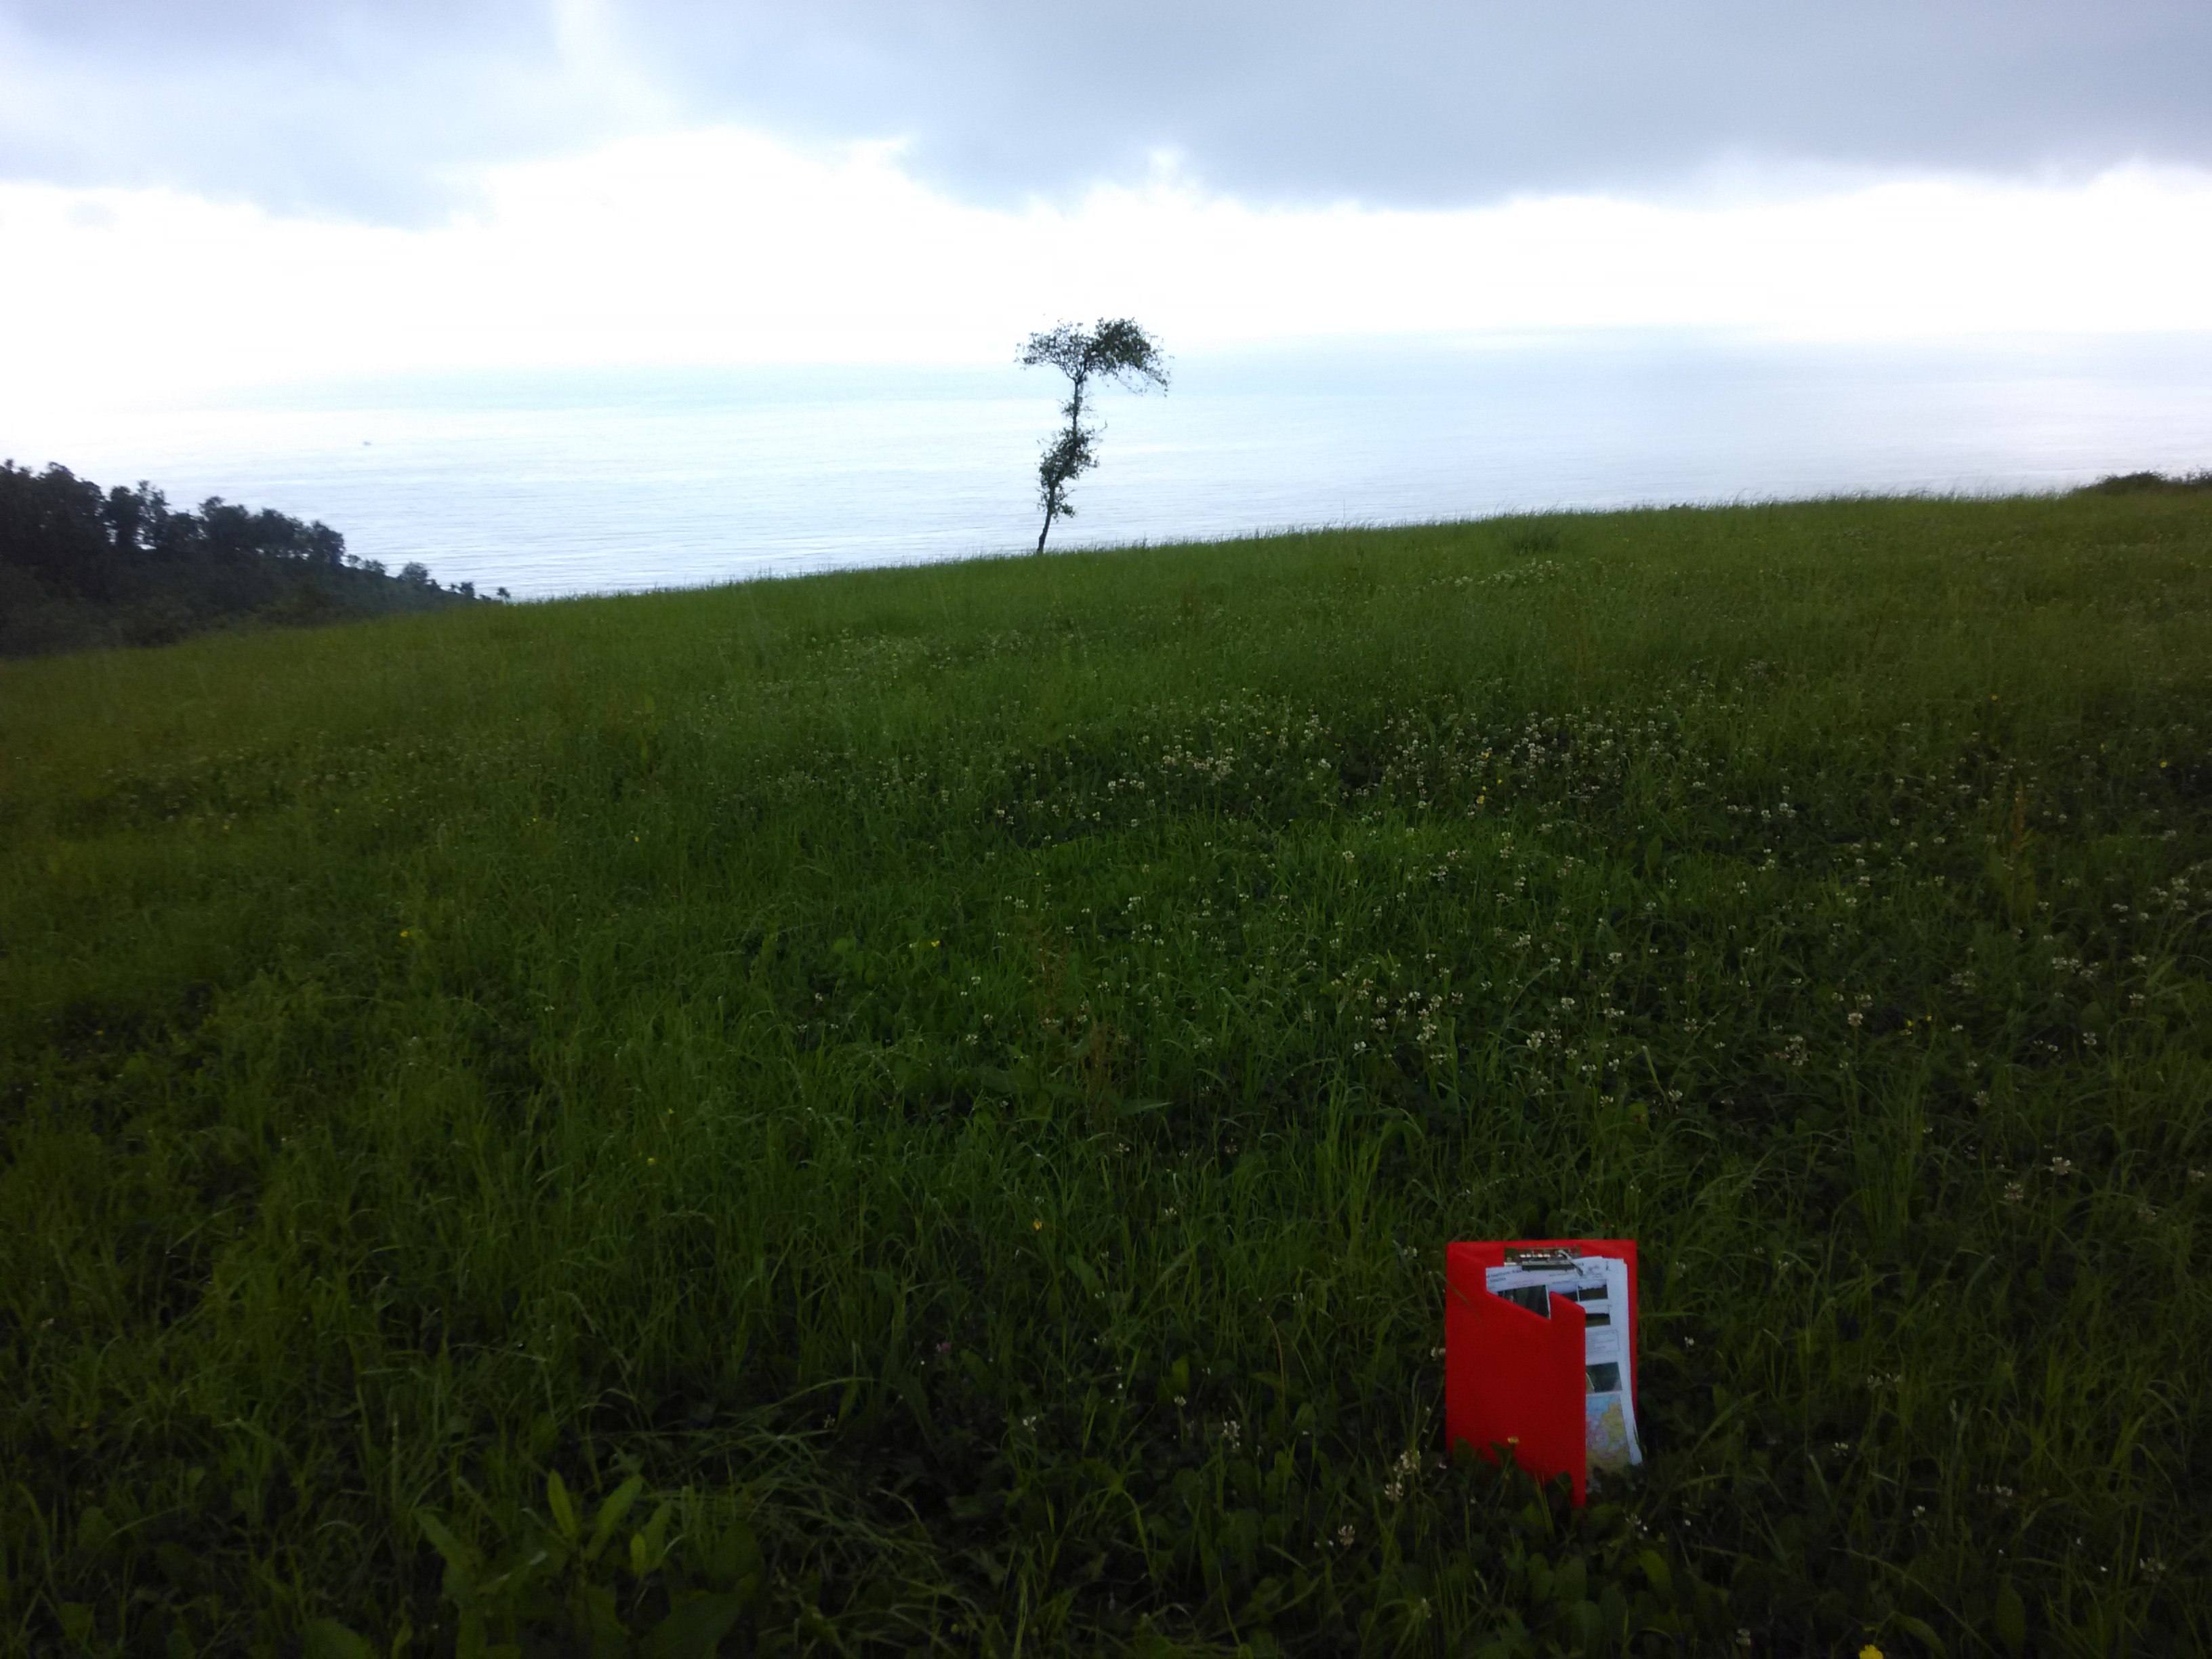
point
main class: Grassland
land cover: Grassland without tree/shrub cover
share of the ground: > 75 %
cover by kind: herbaceous plants 100 %
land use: Agriculture (excluding fallow land and kitchen gardens)
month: June
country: ES
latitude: 43.2889
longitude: -2.2889
